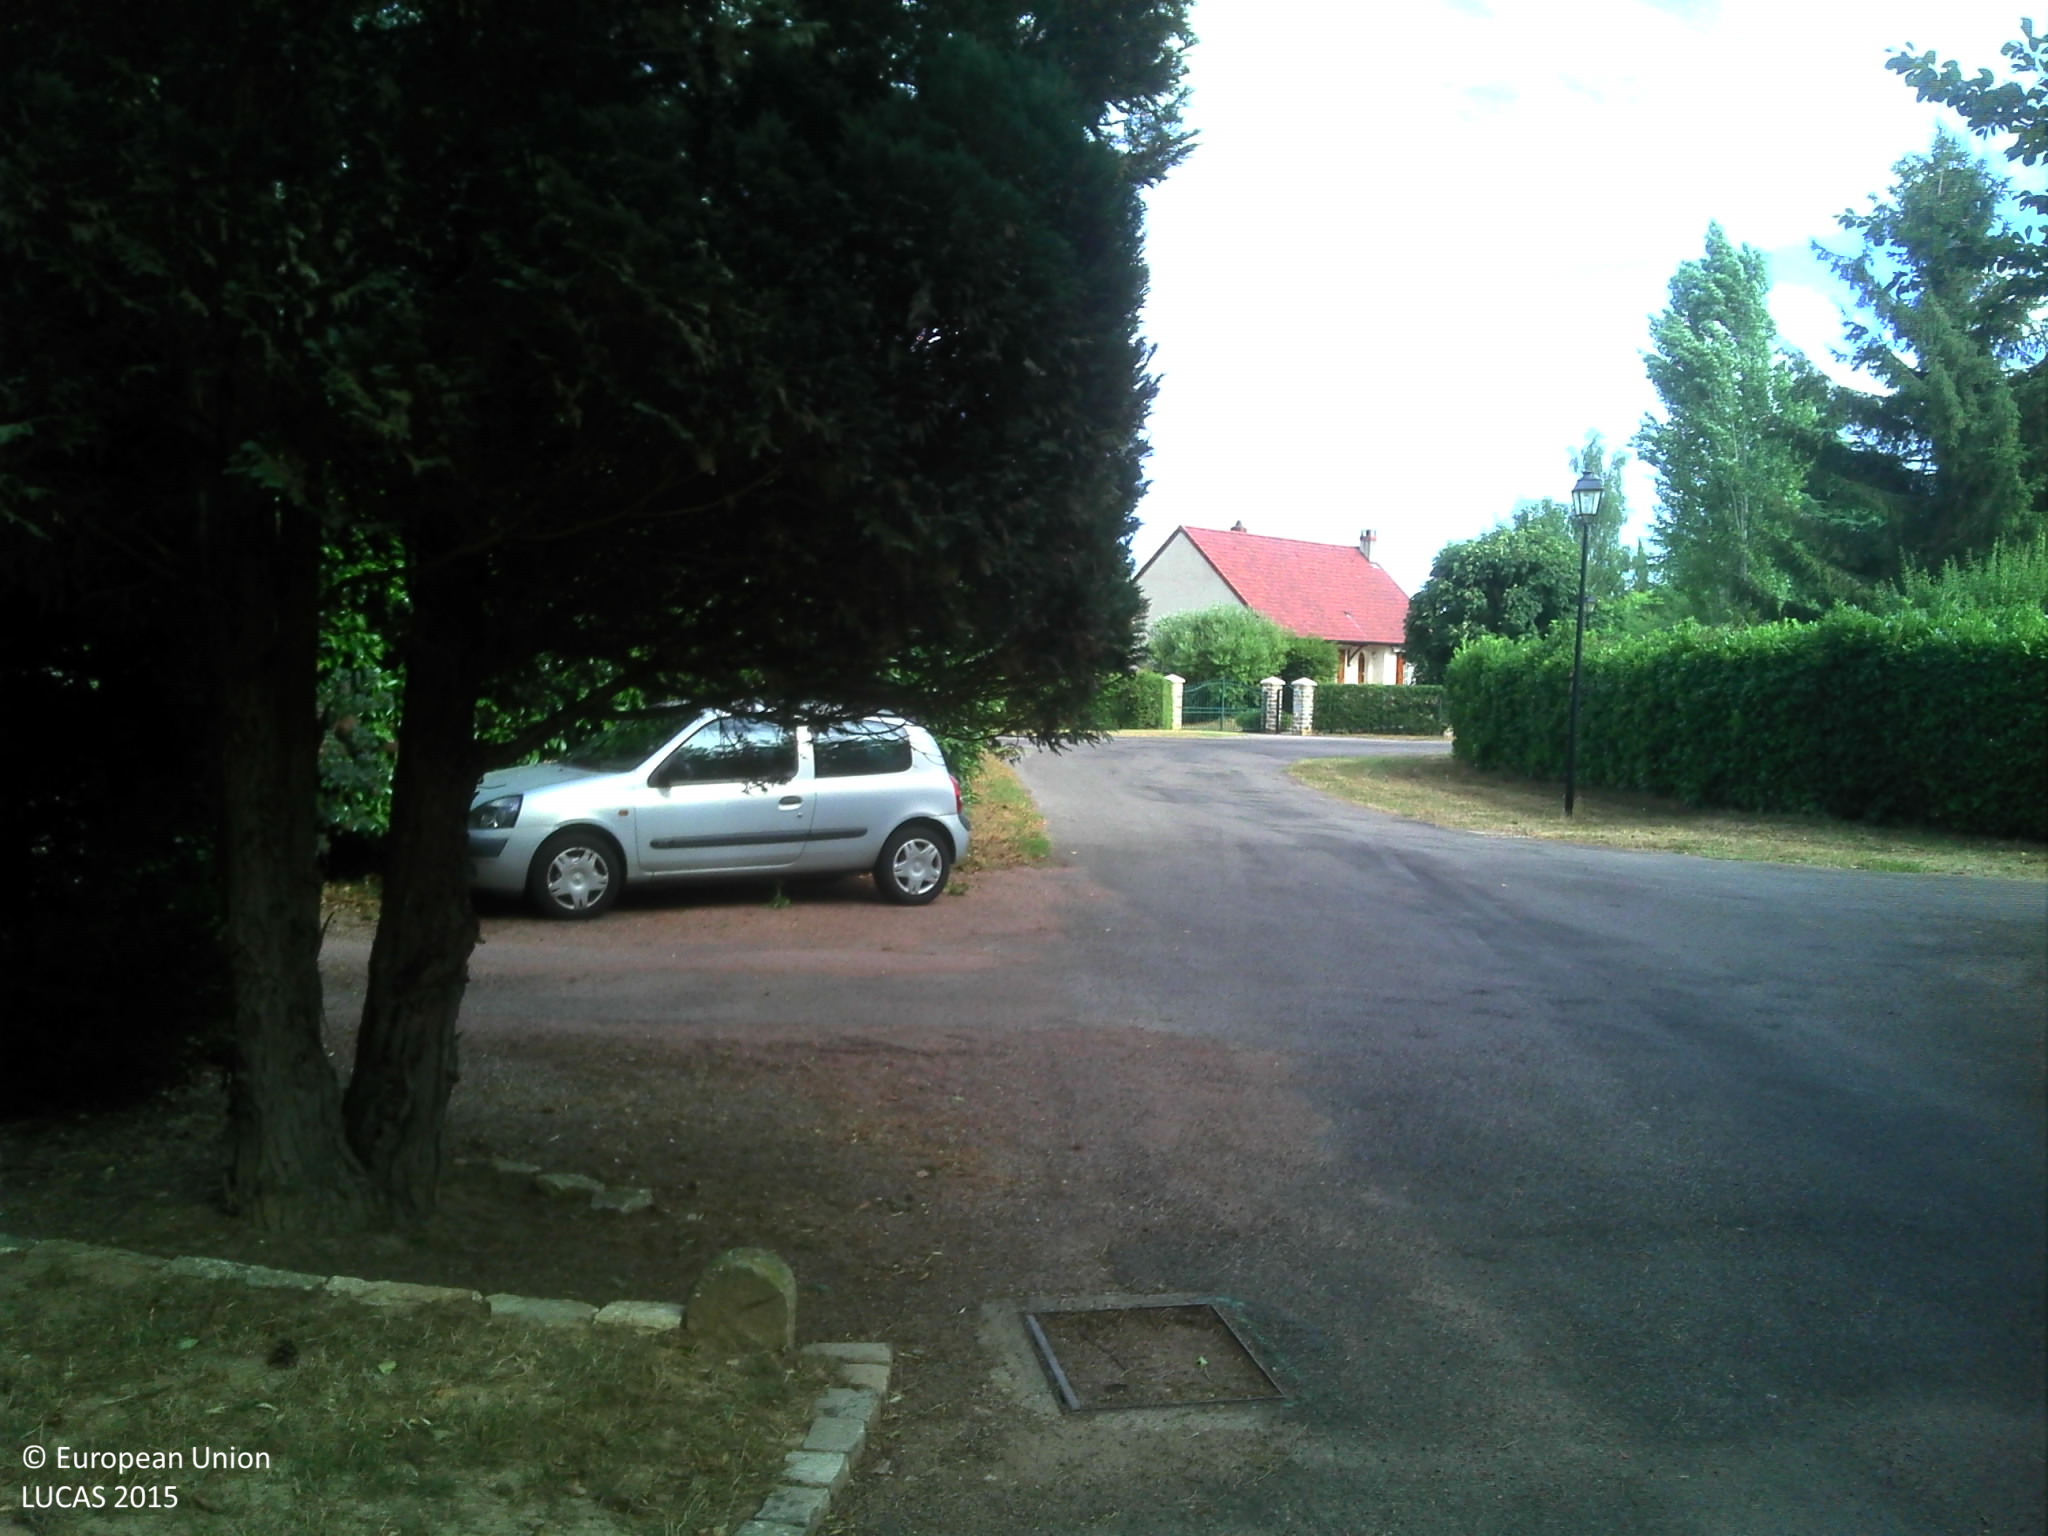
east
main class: Woodland
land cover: Broadleaved woodland
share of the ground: > 75 %
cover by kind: broadleaved forest trees 65 %, herbaceous plants 35 %
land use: Residential
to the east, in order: Broadleaved woodland; Artificial constructions in urban areas; Grassland without tree/shrub cover
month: July
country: FR
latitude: 46.8009
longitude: 4.7732
